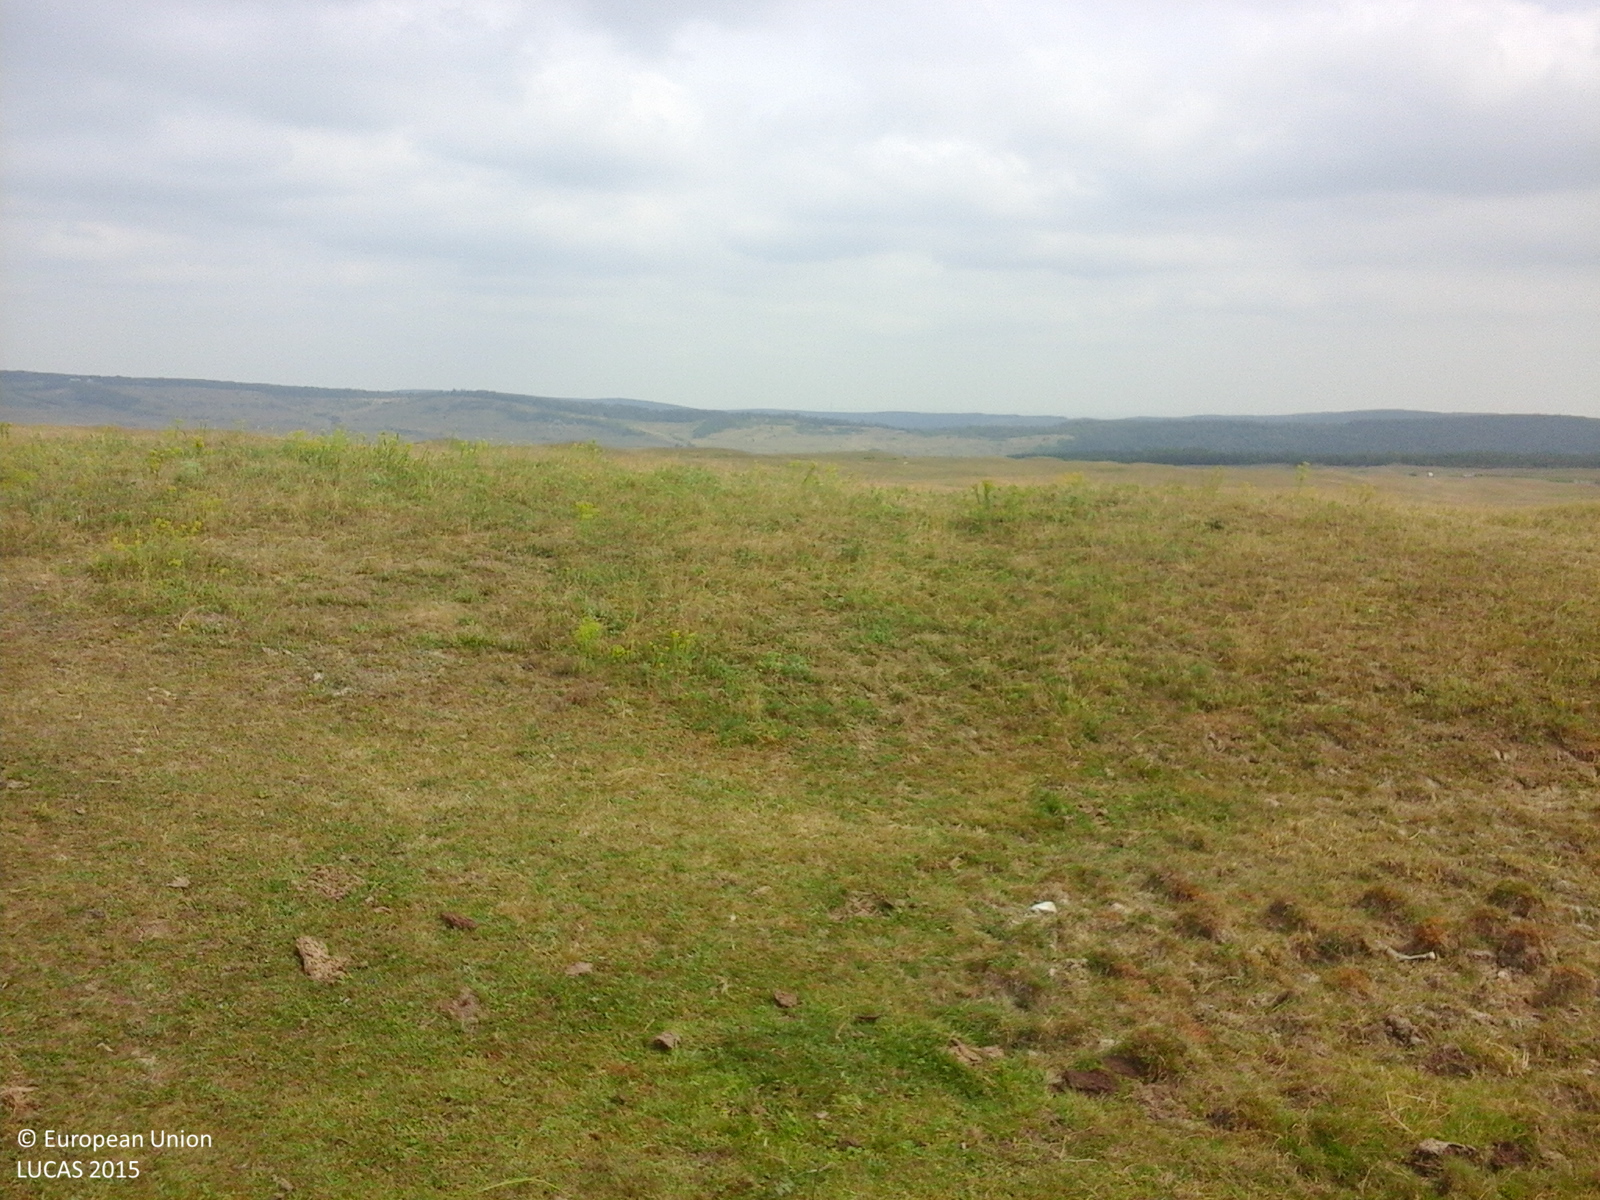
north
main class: Grassland
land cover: Grassland without tree/shrub cover
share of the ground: > 75 %
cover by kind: herbaceous plants 100 %
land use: Agriculture (excluding fallow land and kitchen gardens)
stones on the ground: < 10 %
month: June
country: RO
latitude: 47.6316
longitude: 26.6085
